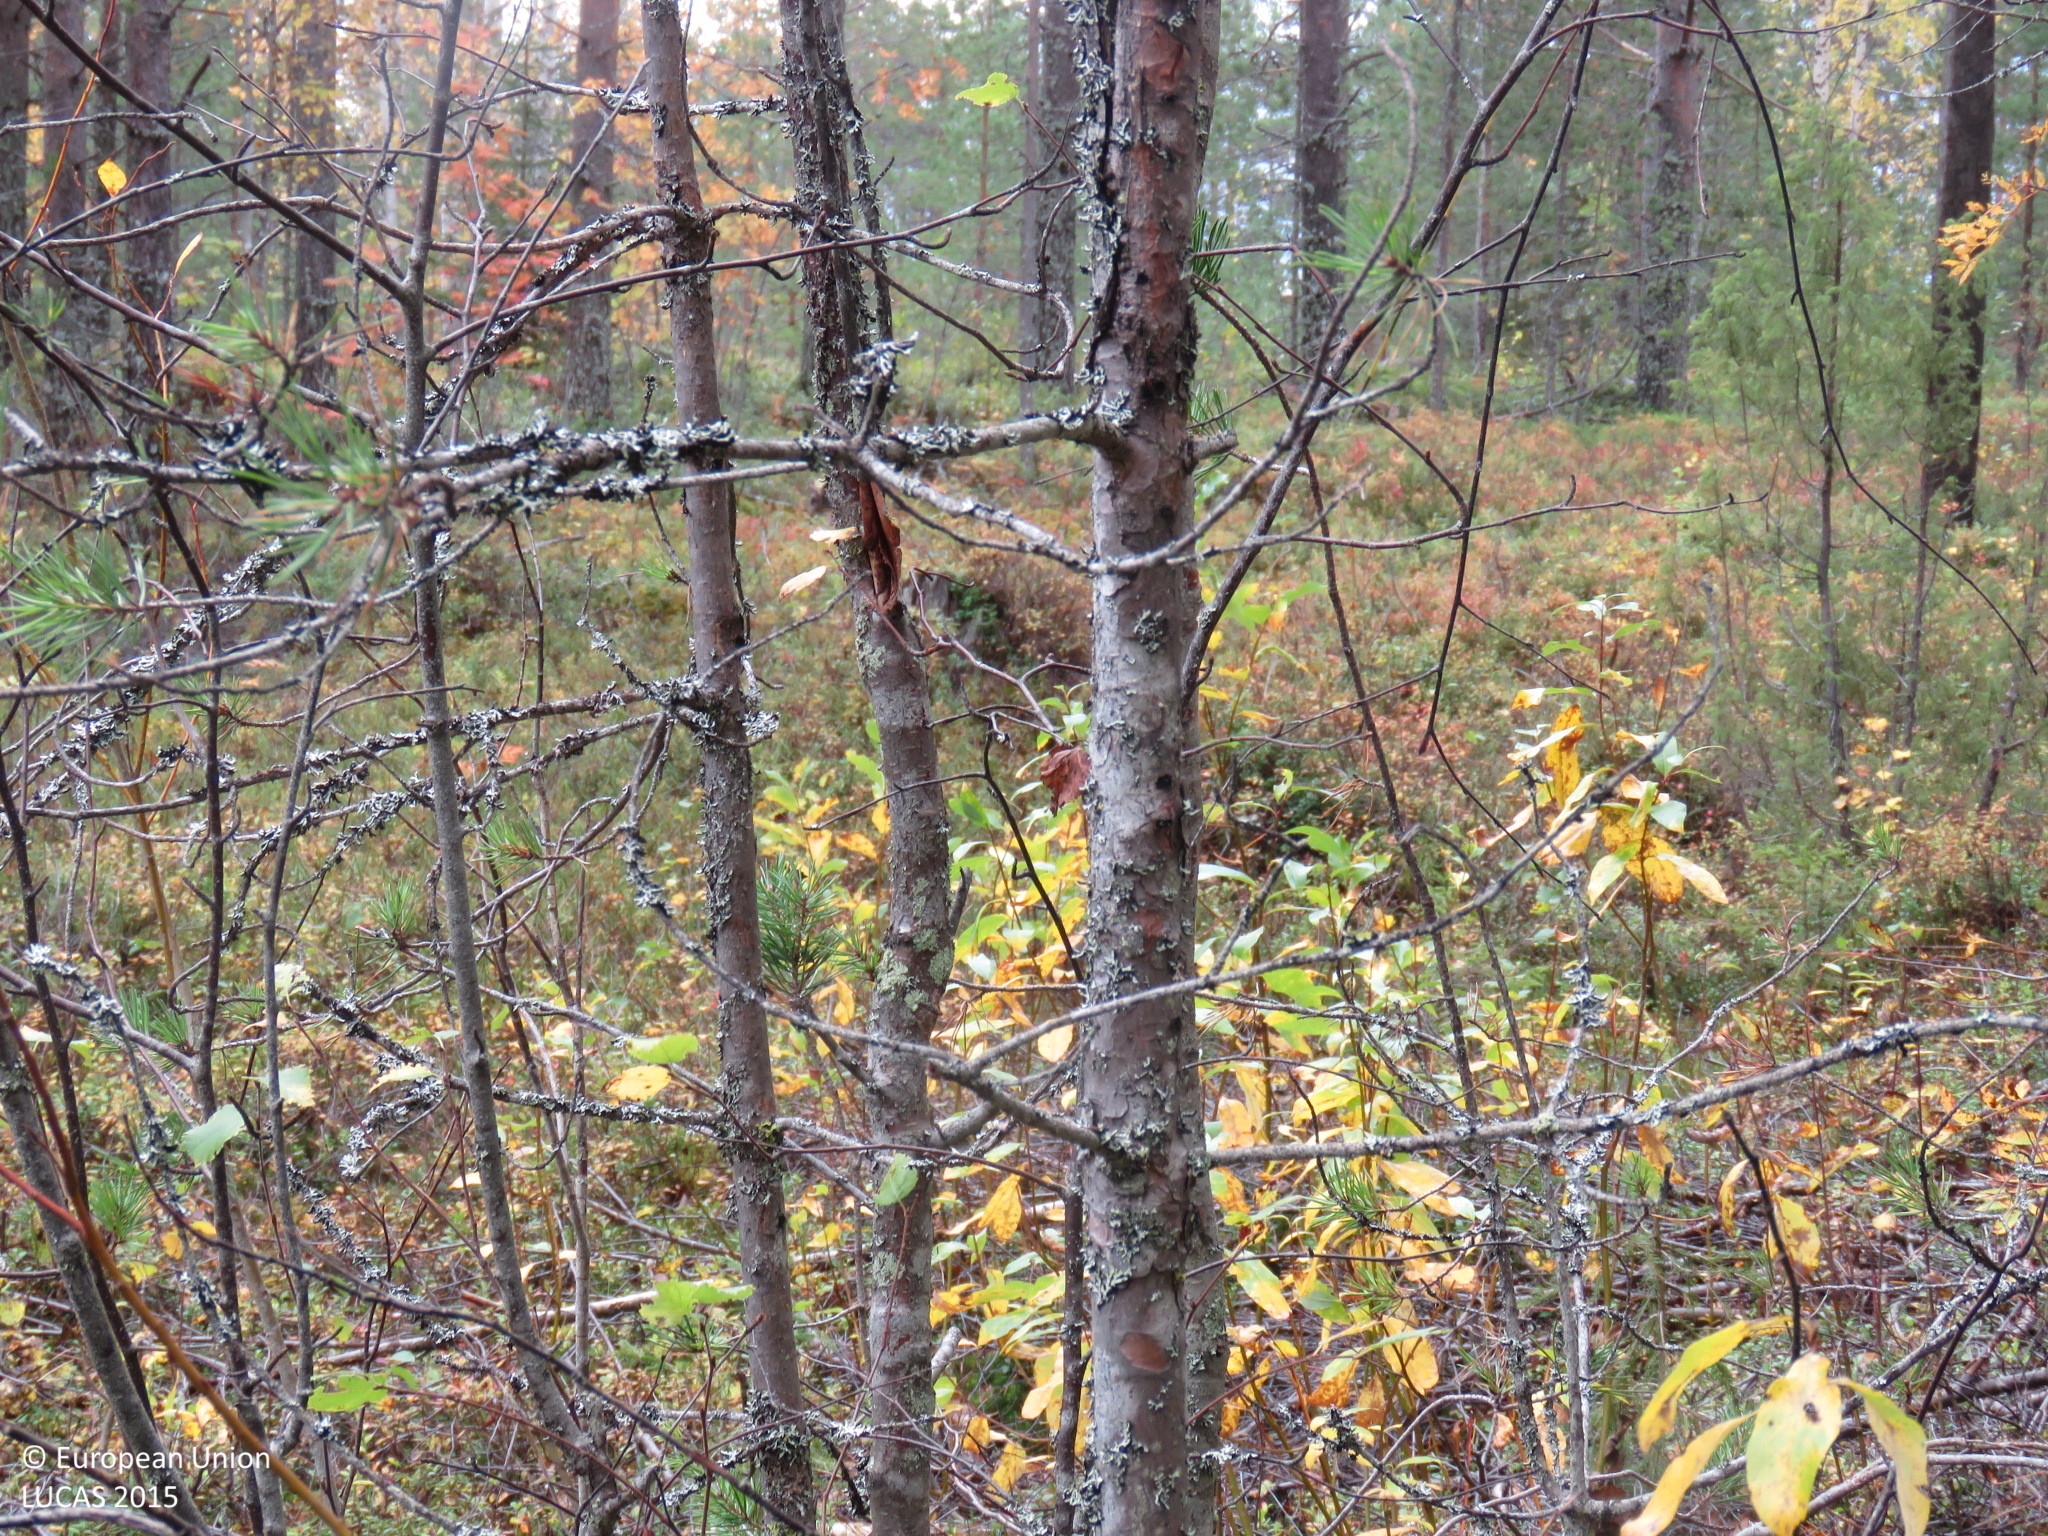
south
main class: Woodland
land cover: Pine dominated mixed woodland
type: boreal forest
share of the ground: > 75 %
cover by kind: broadleaved forest trees 45 %, coniferous forest trees 40 %, shrubs 15 %
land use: Forestry
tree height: > 5 m
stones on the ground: < 10 %
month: September
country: FI
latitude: 65.0660
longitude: 27.0224
